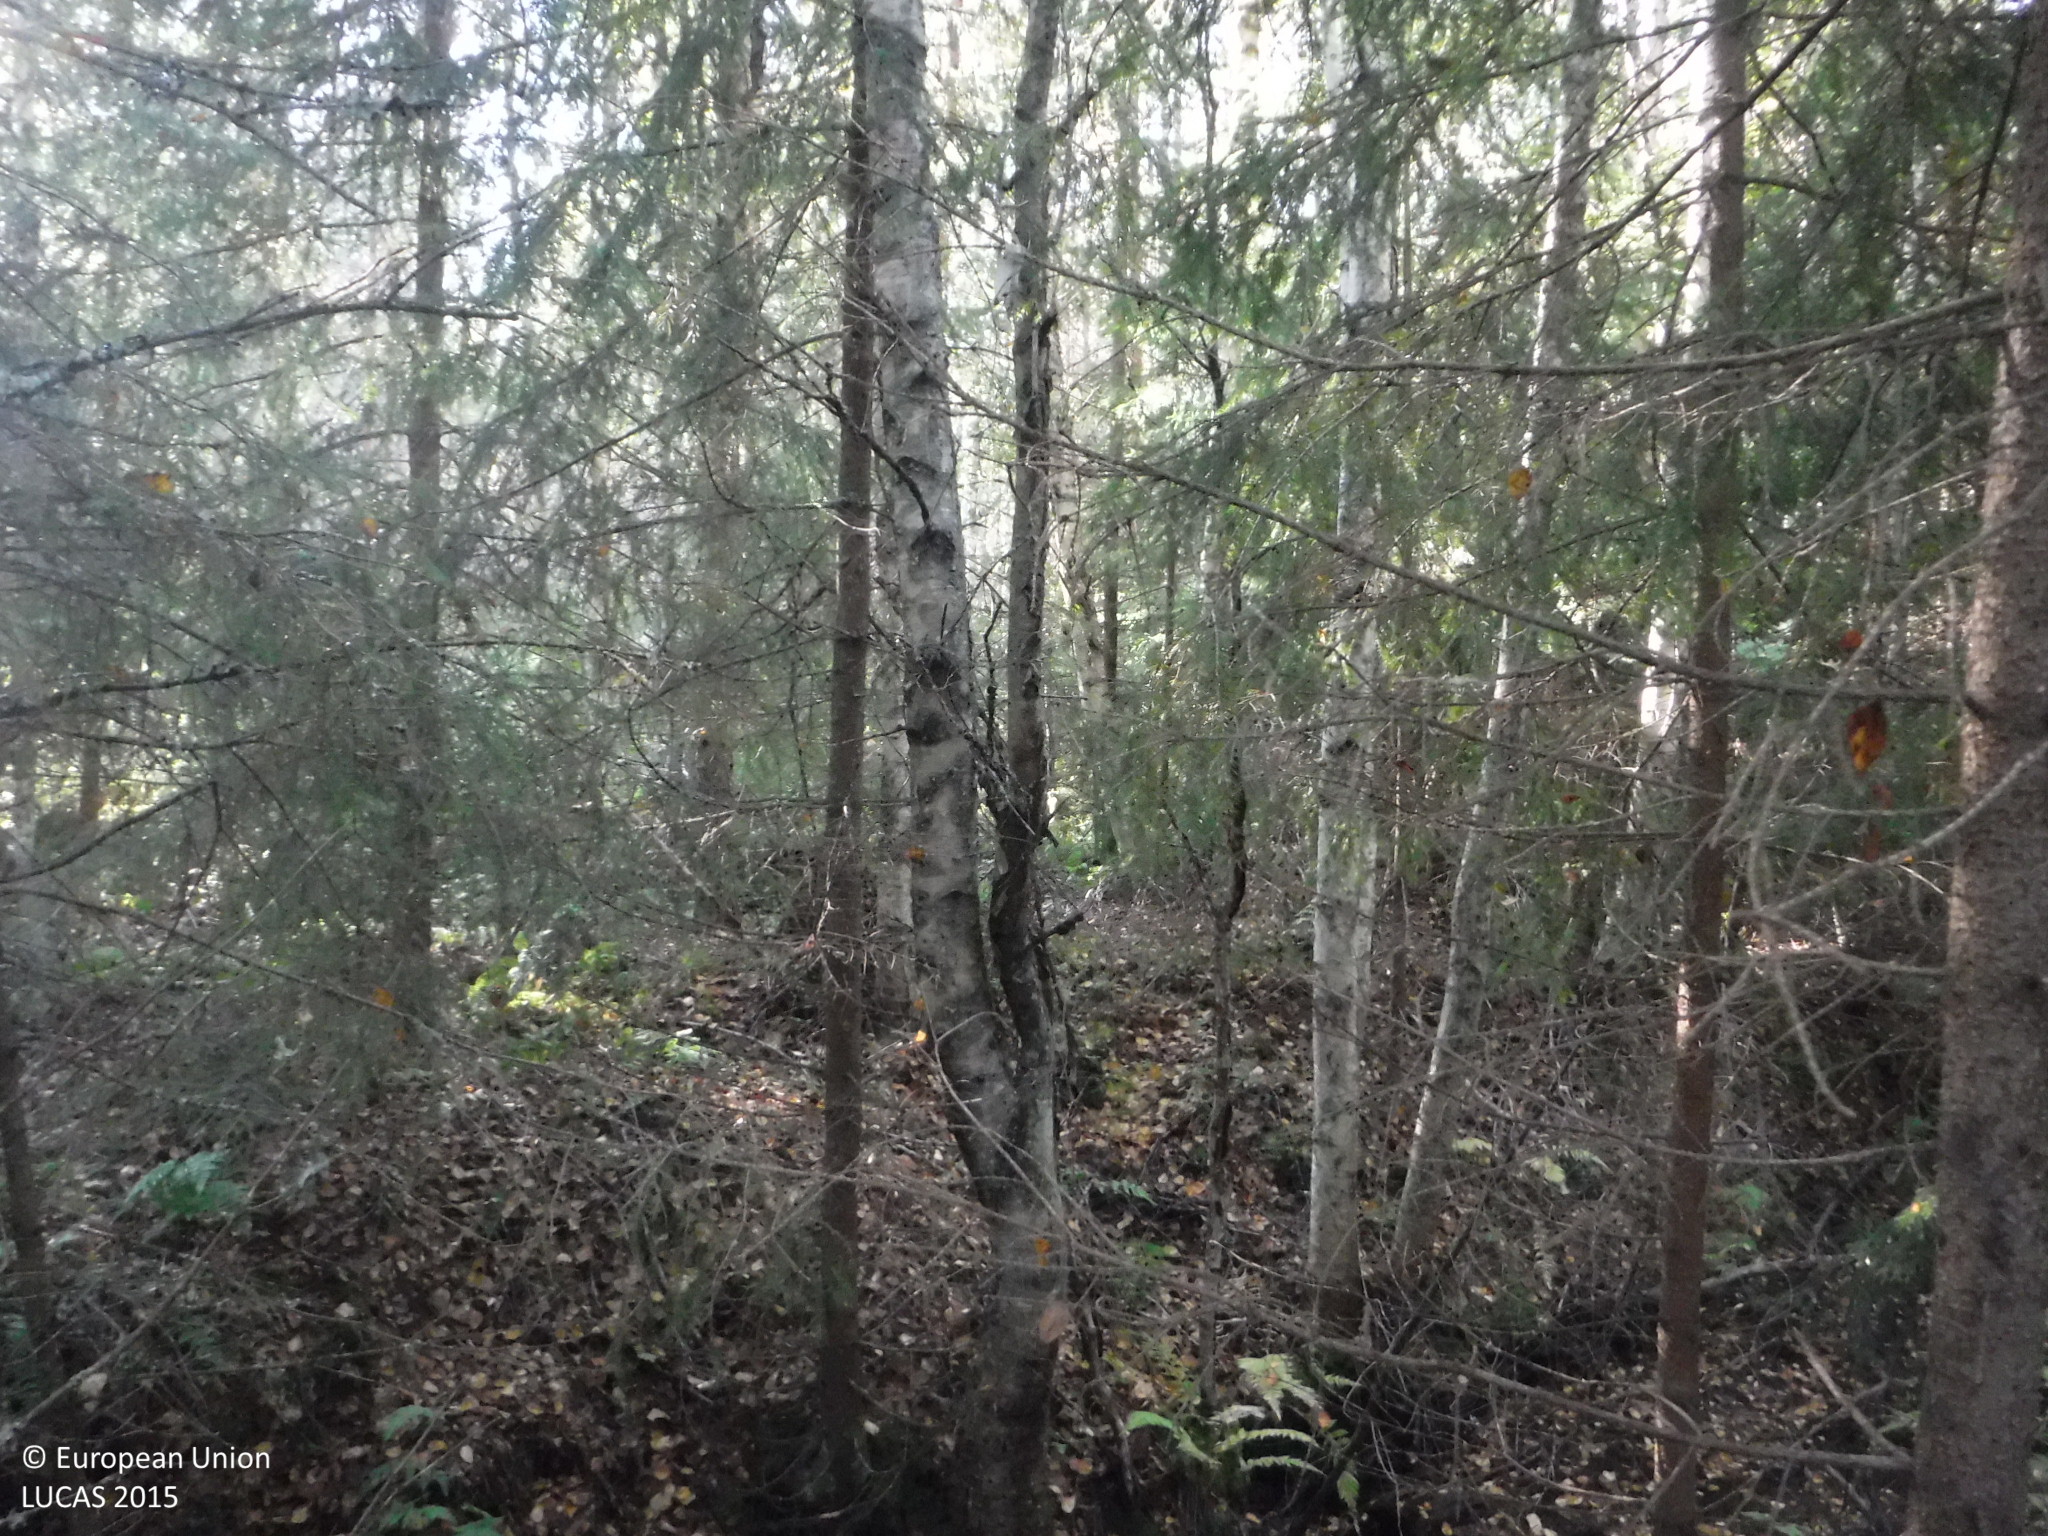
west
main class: Woodland
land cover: Spruce dominated mixed woodland
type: boreal forest
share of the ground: 50 - 75 %
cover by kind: coniferous forest trees 30 %, broadleaved forest trees 30 %, herbaceous plants 30 %, shrubs 5 %, lichens and mosses 5 %
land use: Forestry
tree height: > 5 m
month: September
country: FI
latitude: 61.6836
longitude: 22.7464
